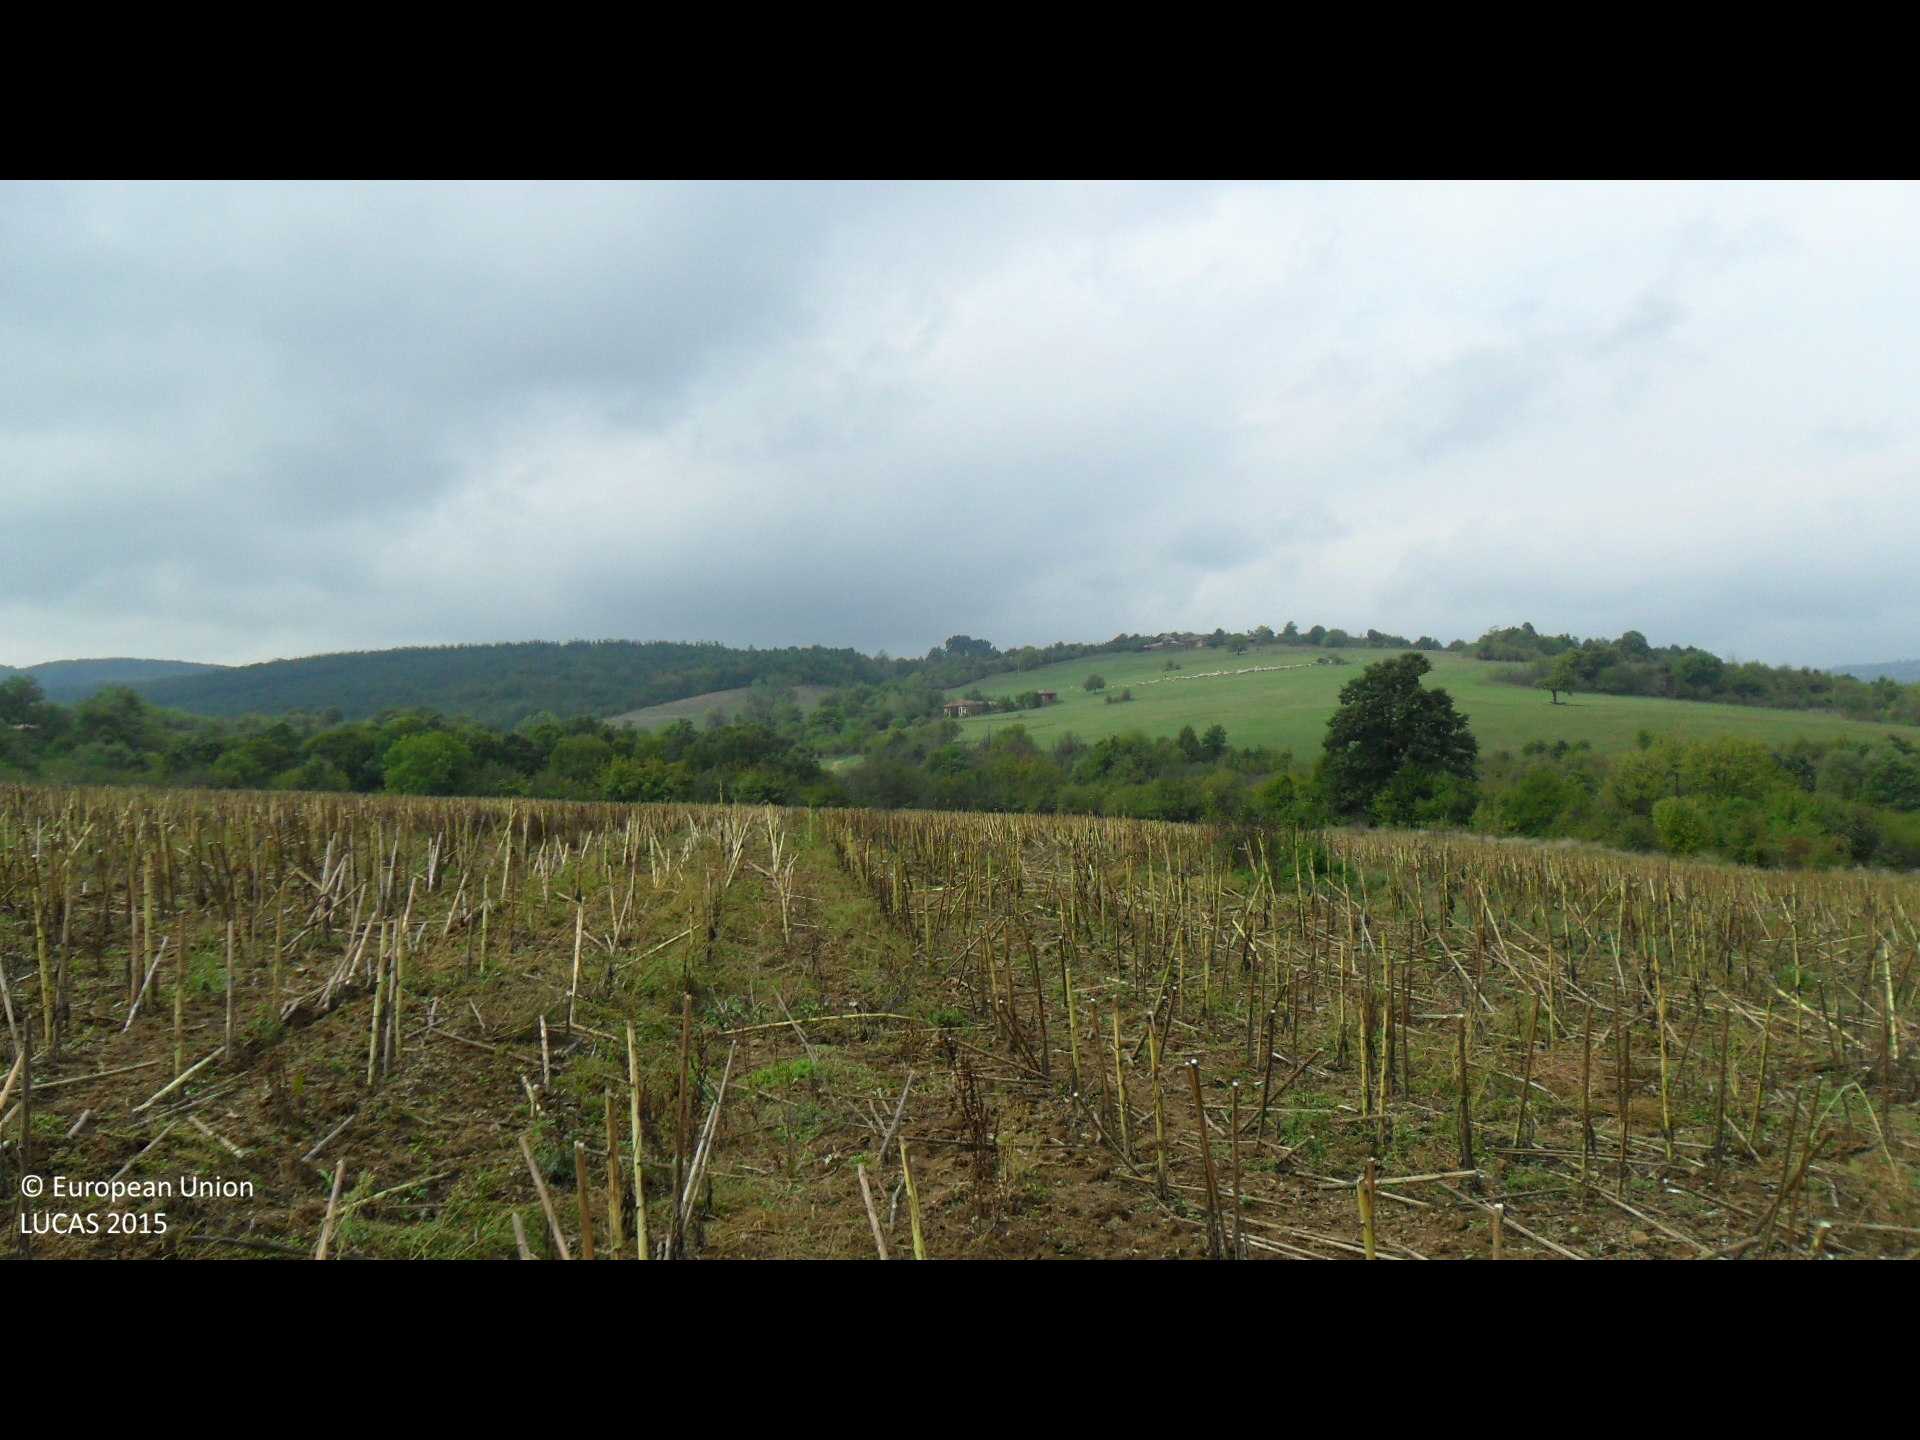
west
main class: Cropland
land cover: Sunflower
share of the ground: 50 - 75 %
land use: Agriculture (excluding fallow land and kitchen gardens)
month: September
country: BG
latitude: 43.0668
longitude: 26.3170
